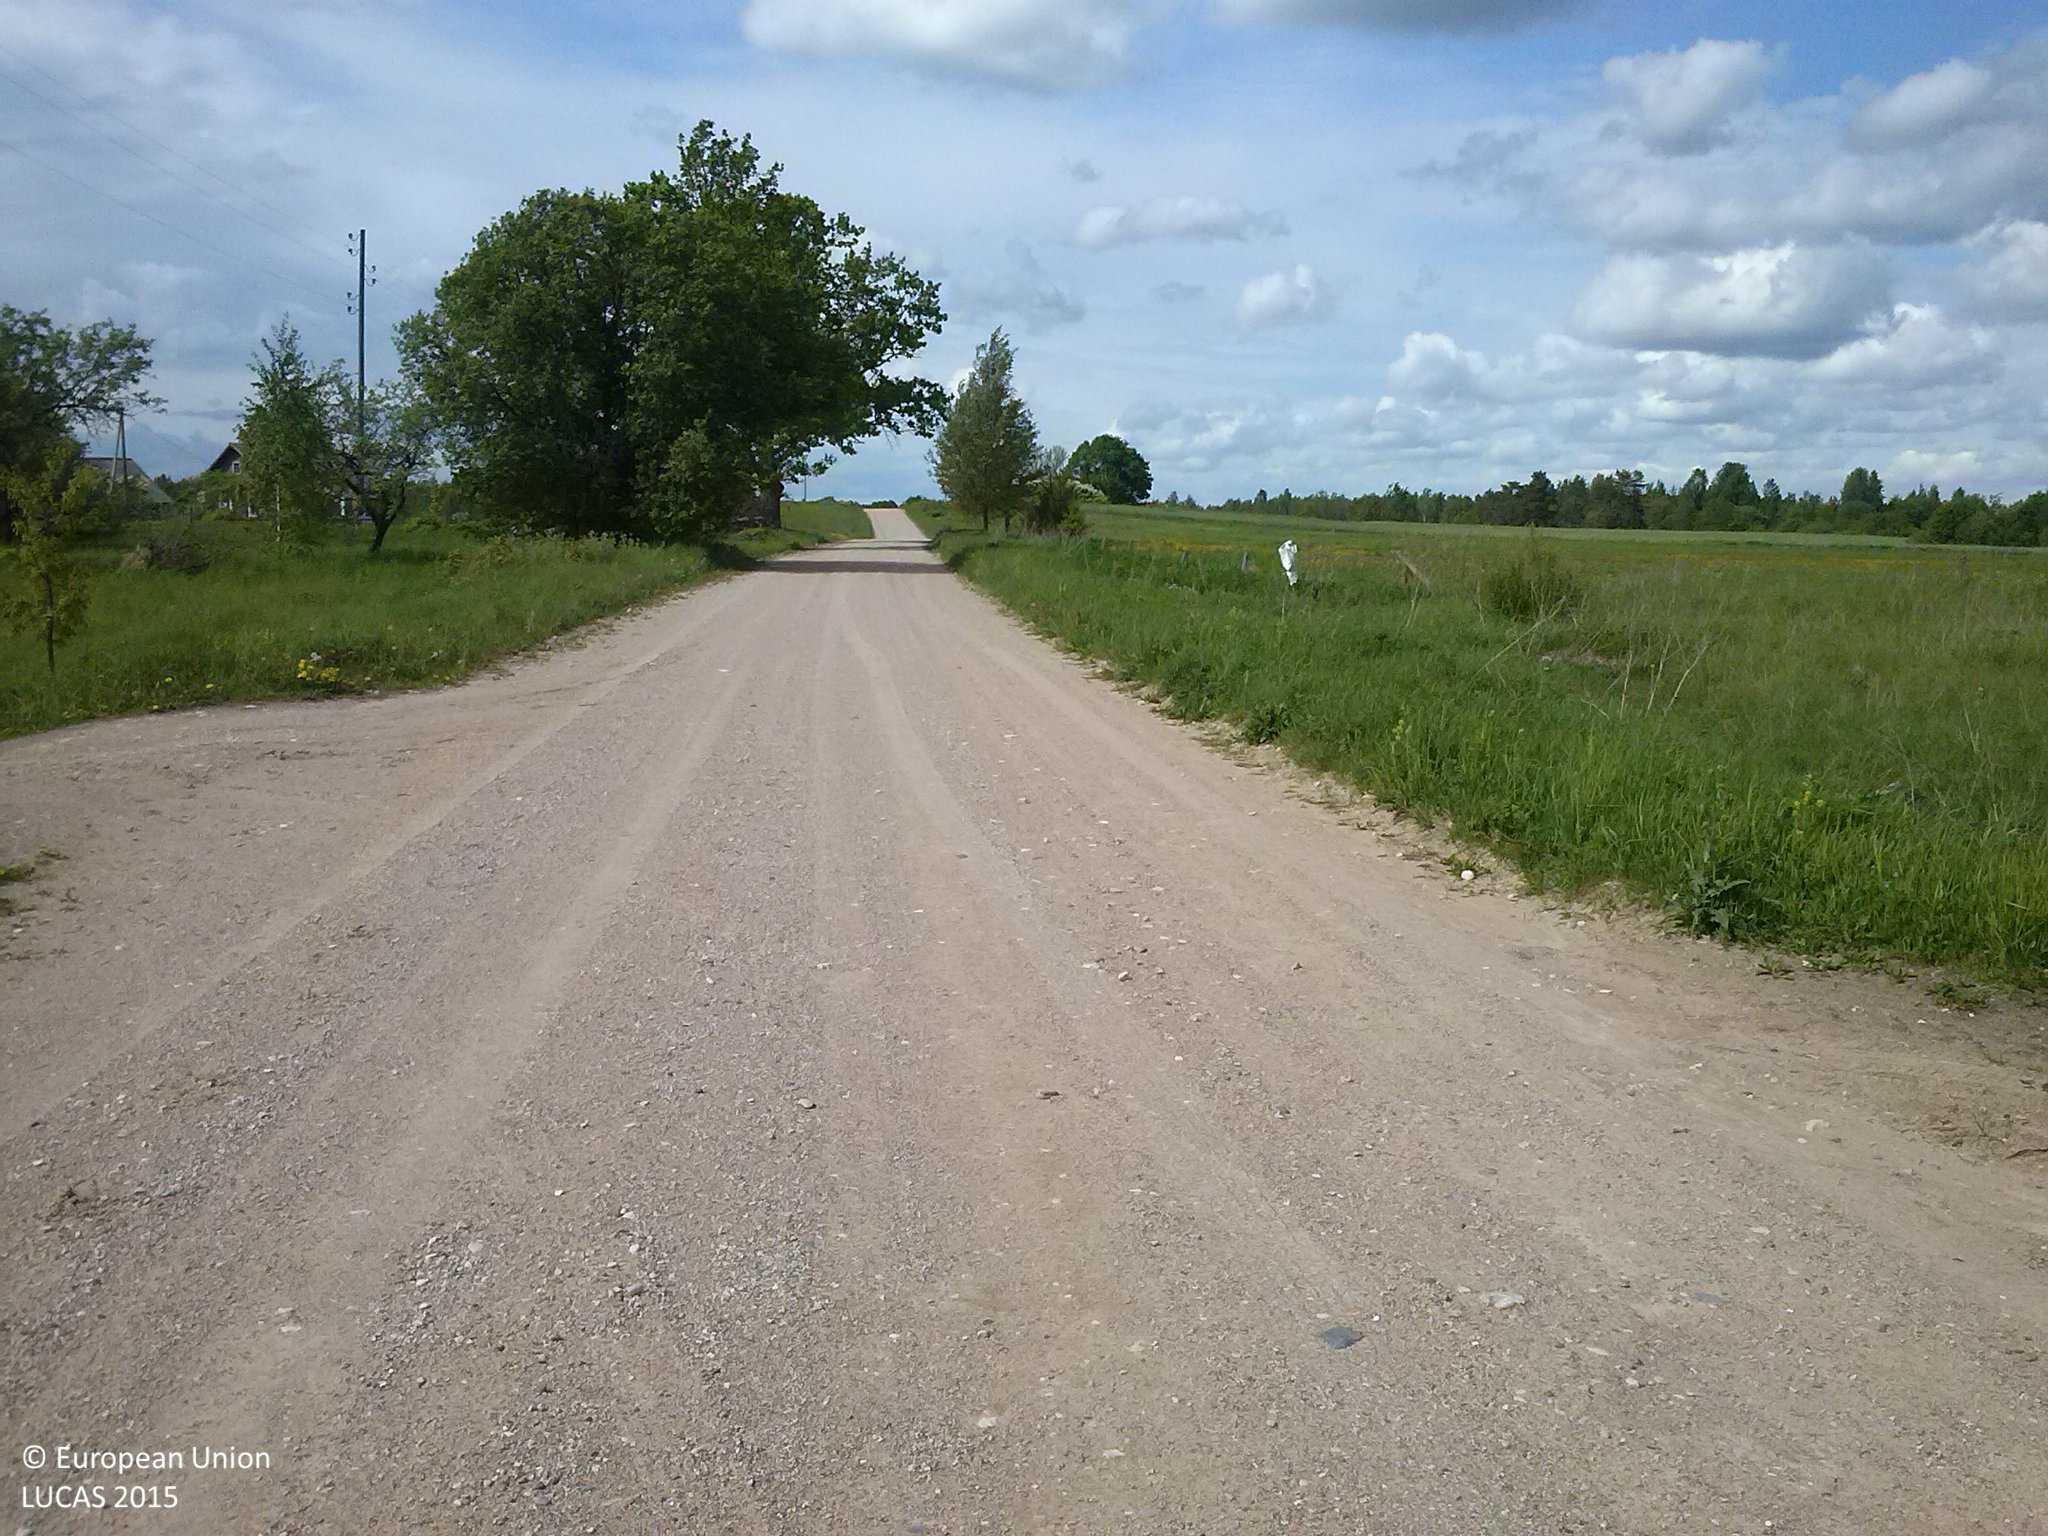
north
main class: Grassland
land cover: Grassland without tree/shrub cover
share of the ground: > 75 %
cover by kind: herbaceous plants 100 %
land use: Agriculture (excluding fallow land and kitchen gardens)
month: May
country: LV
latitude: 56.2399
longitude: 27.7937
